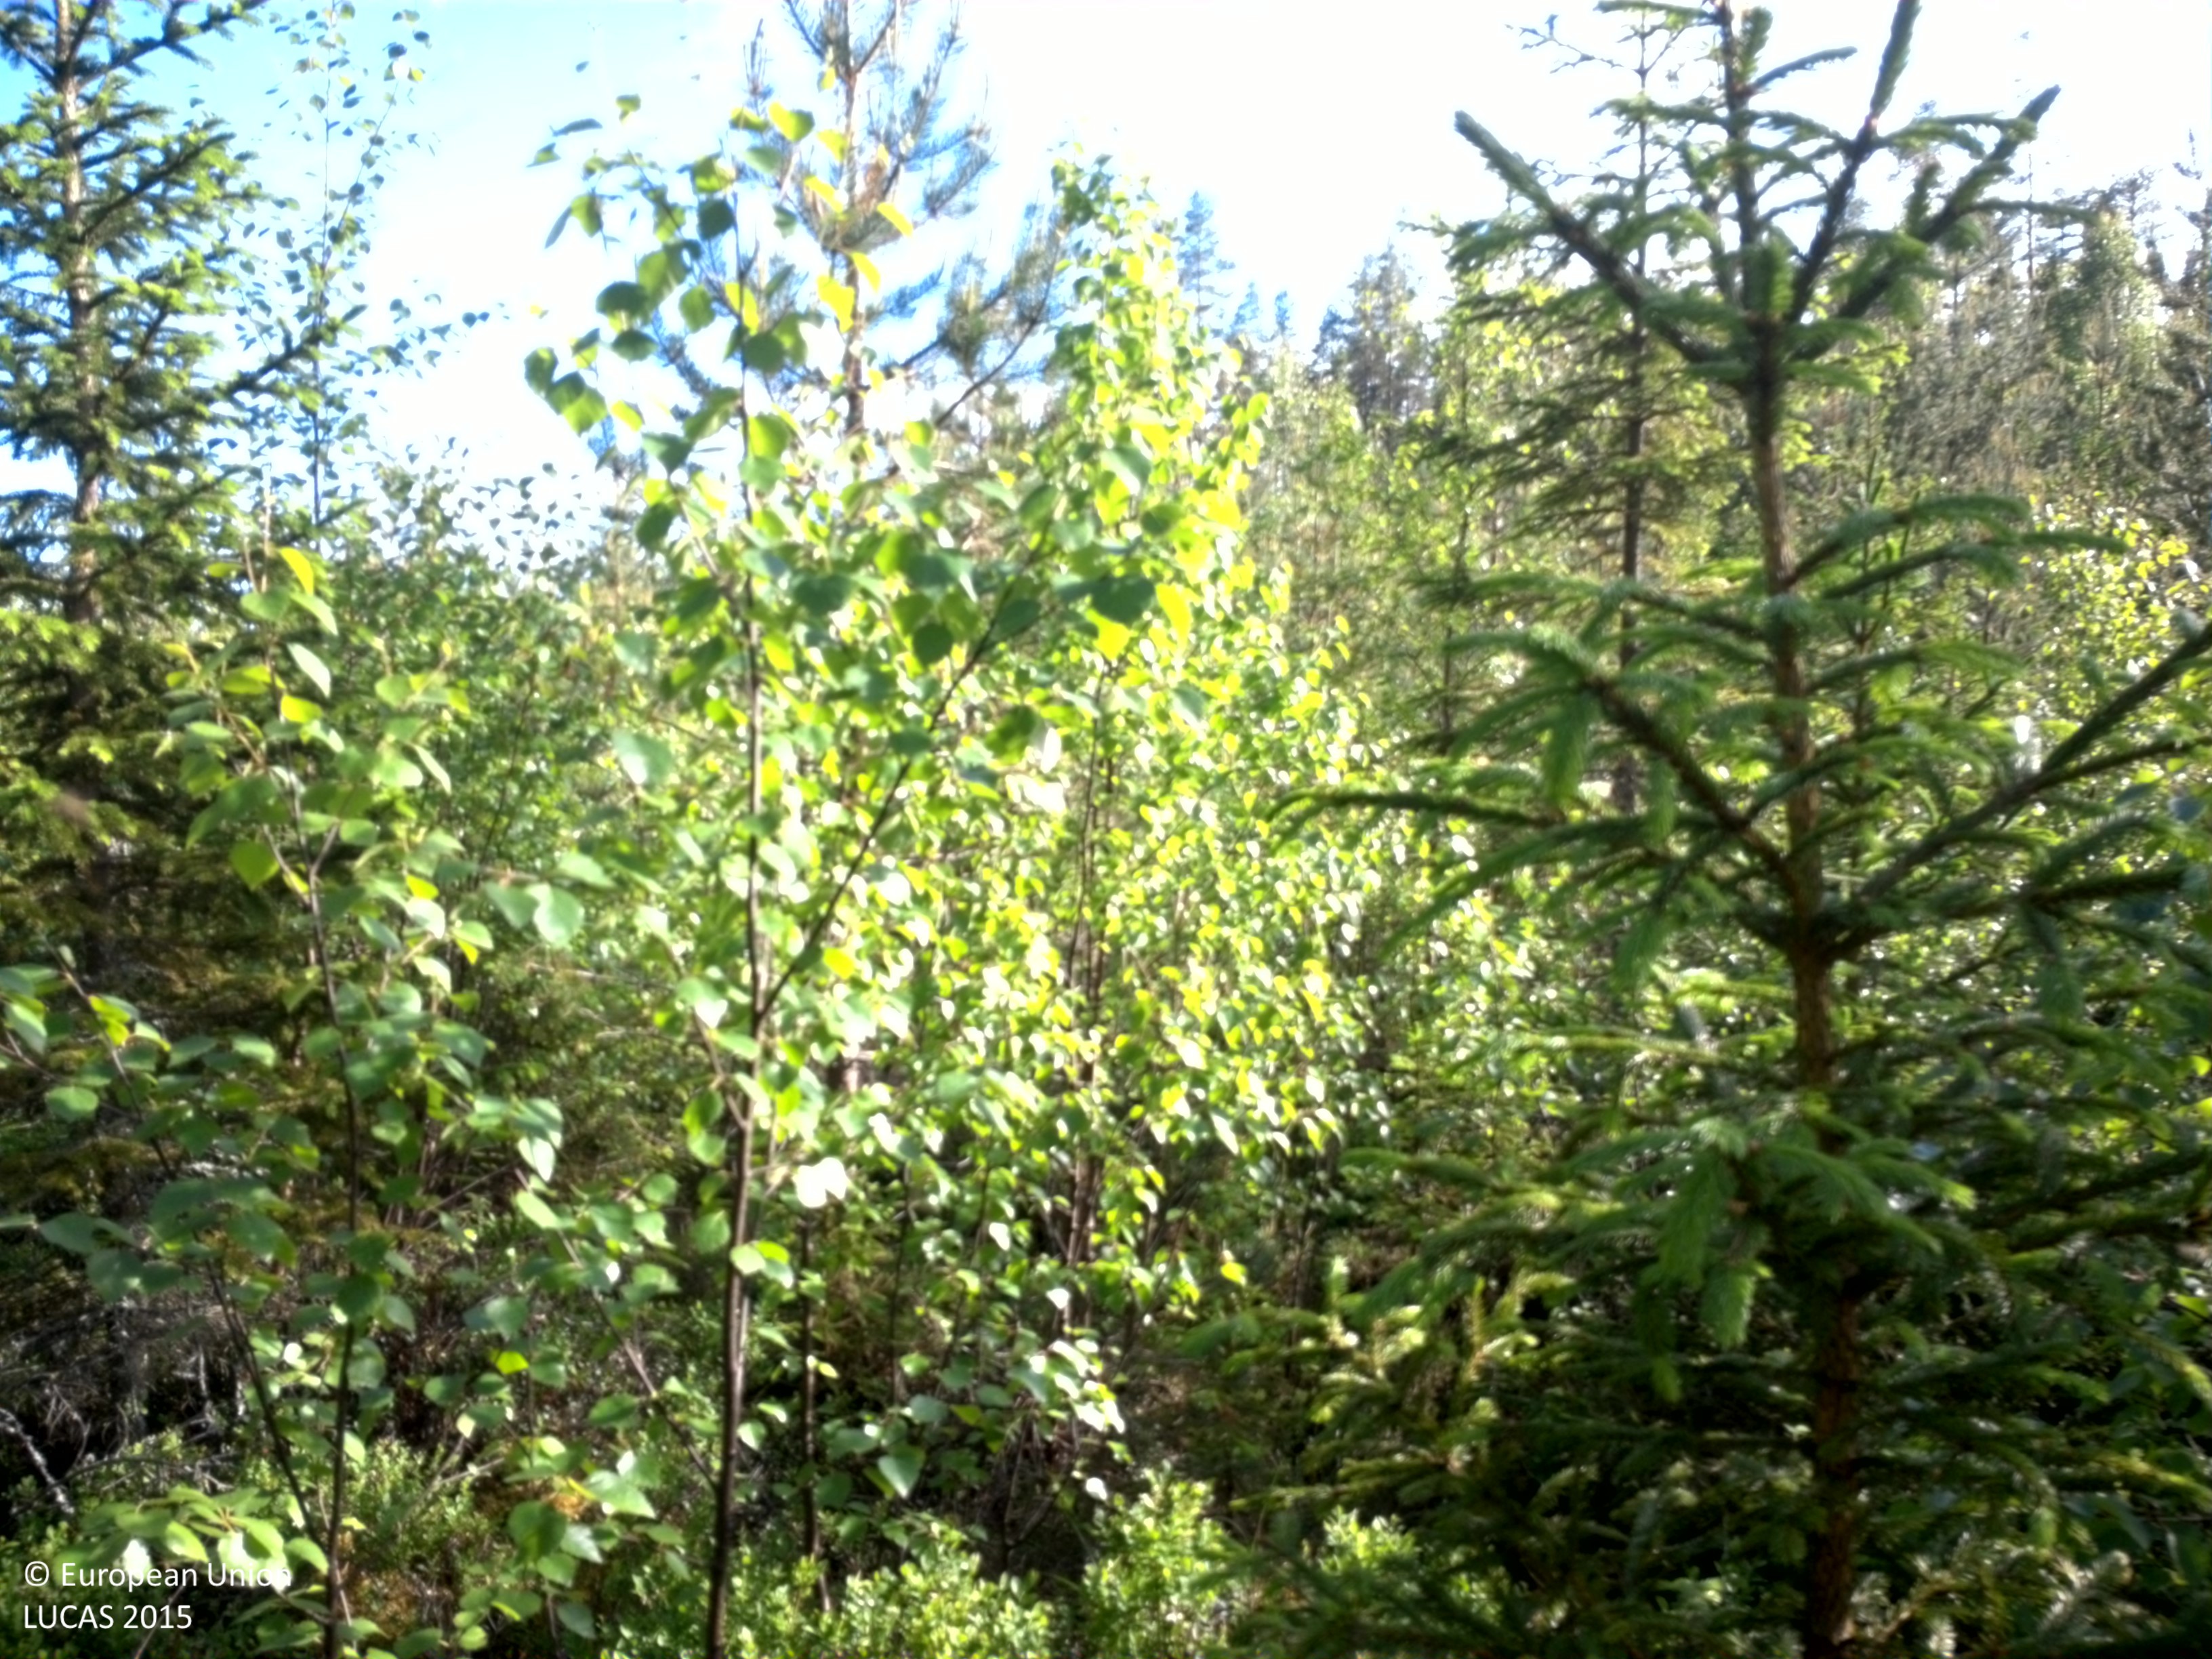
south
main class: Woodland
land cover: Spruce dominated mixed woodland
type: boreal forest
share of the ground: 25 - 50 %
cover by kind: coniferous forest trees 30 %, shrubs 25 %, herbaceous plants 25 %, broadleaved forest trees 20 %
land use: Forestry
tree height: < 5 m
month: June
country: SE
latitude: 64.2198
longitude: 20.6766
